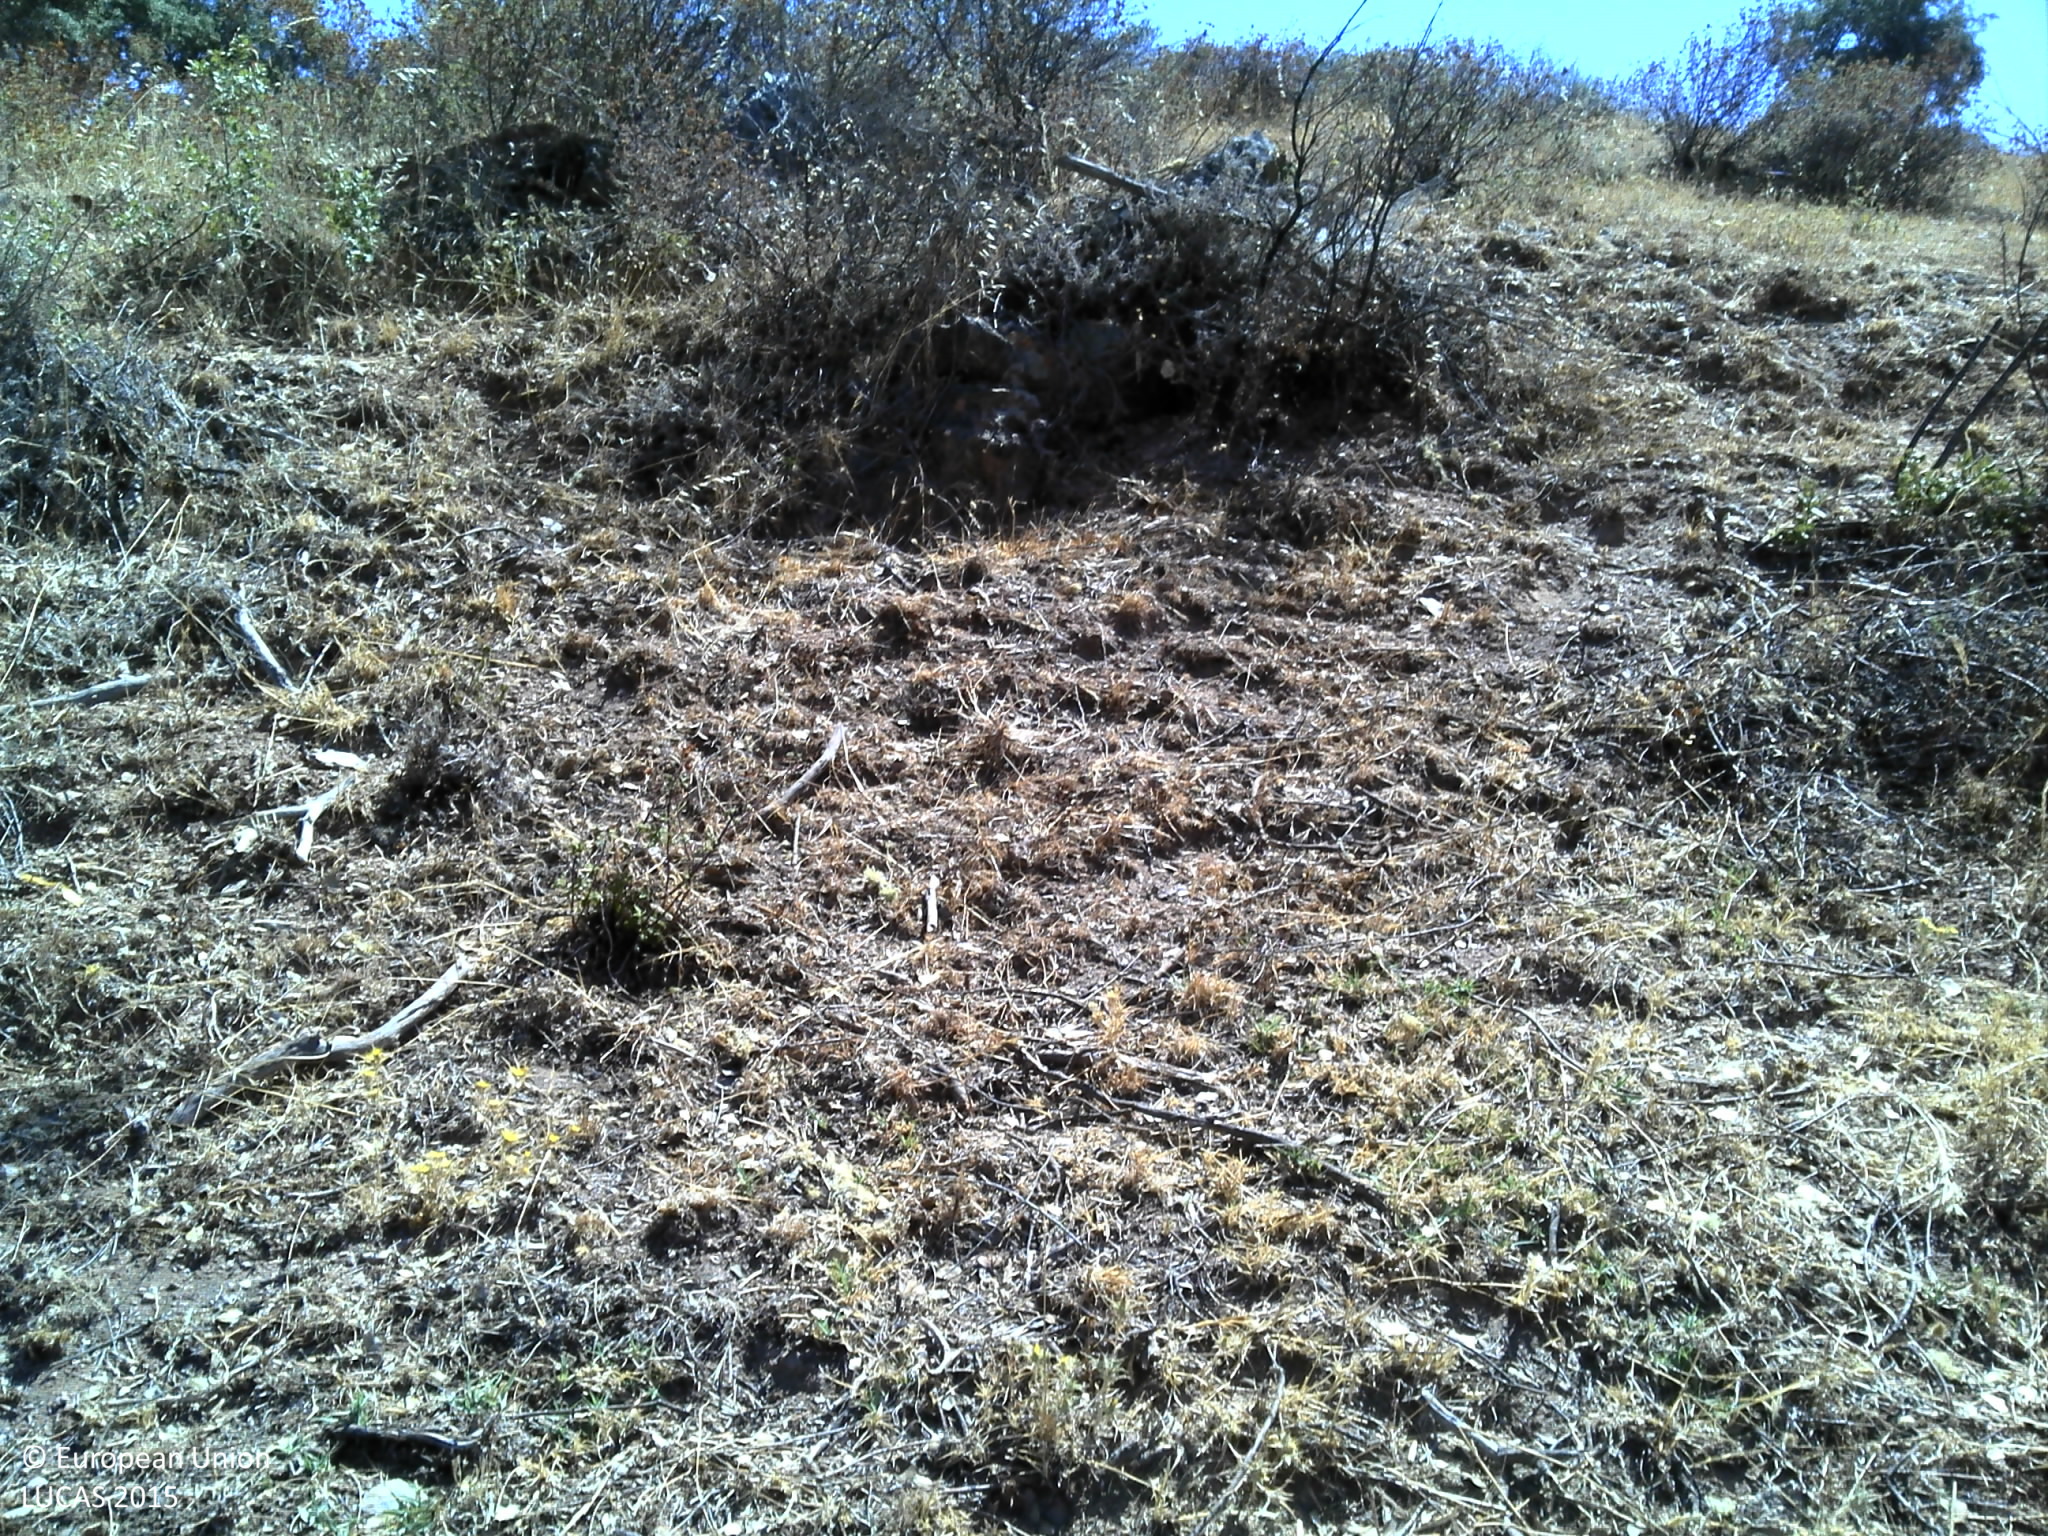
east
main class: Woodland
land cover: Broadleaved woodland
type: broadleaved evergreen forest
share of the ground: 10 - 25 %
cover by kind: broadleaved forest trees 20 %, shrubs 20 %, herbaceous plants 20 %, unconsolidated bare surface 20 %
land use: Forestry
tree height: > 5 m
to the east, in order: Broadleaved woodland; Other structural elements; Broadleaved woodland; Tracks; Grassland with sparse tree/shrub cover; Tracks; Grassland without tree/shrub cover
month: August
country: PT
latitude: 37.9172
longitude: -7.8270
